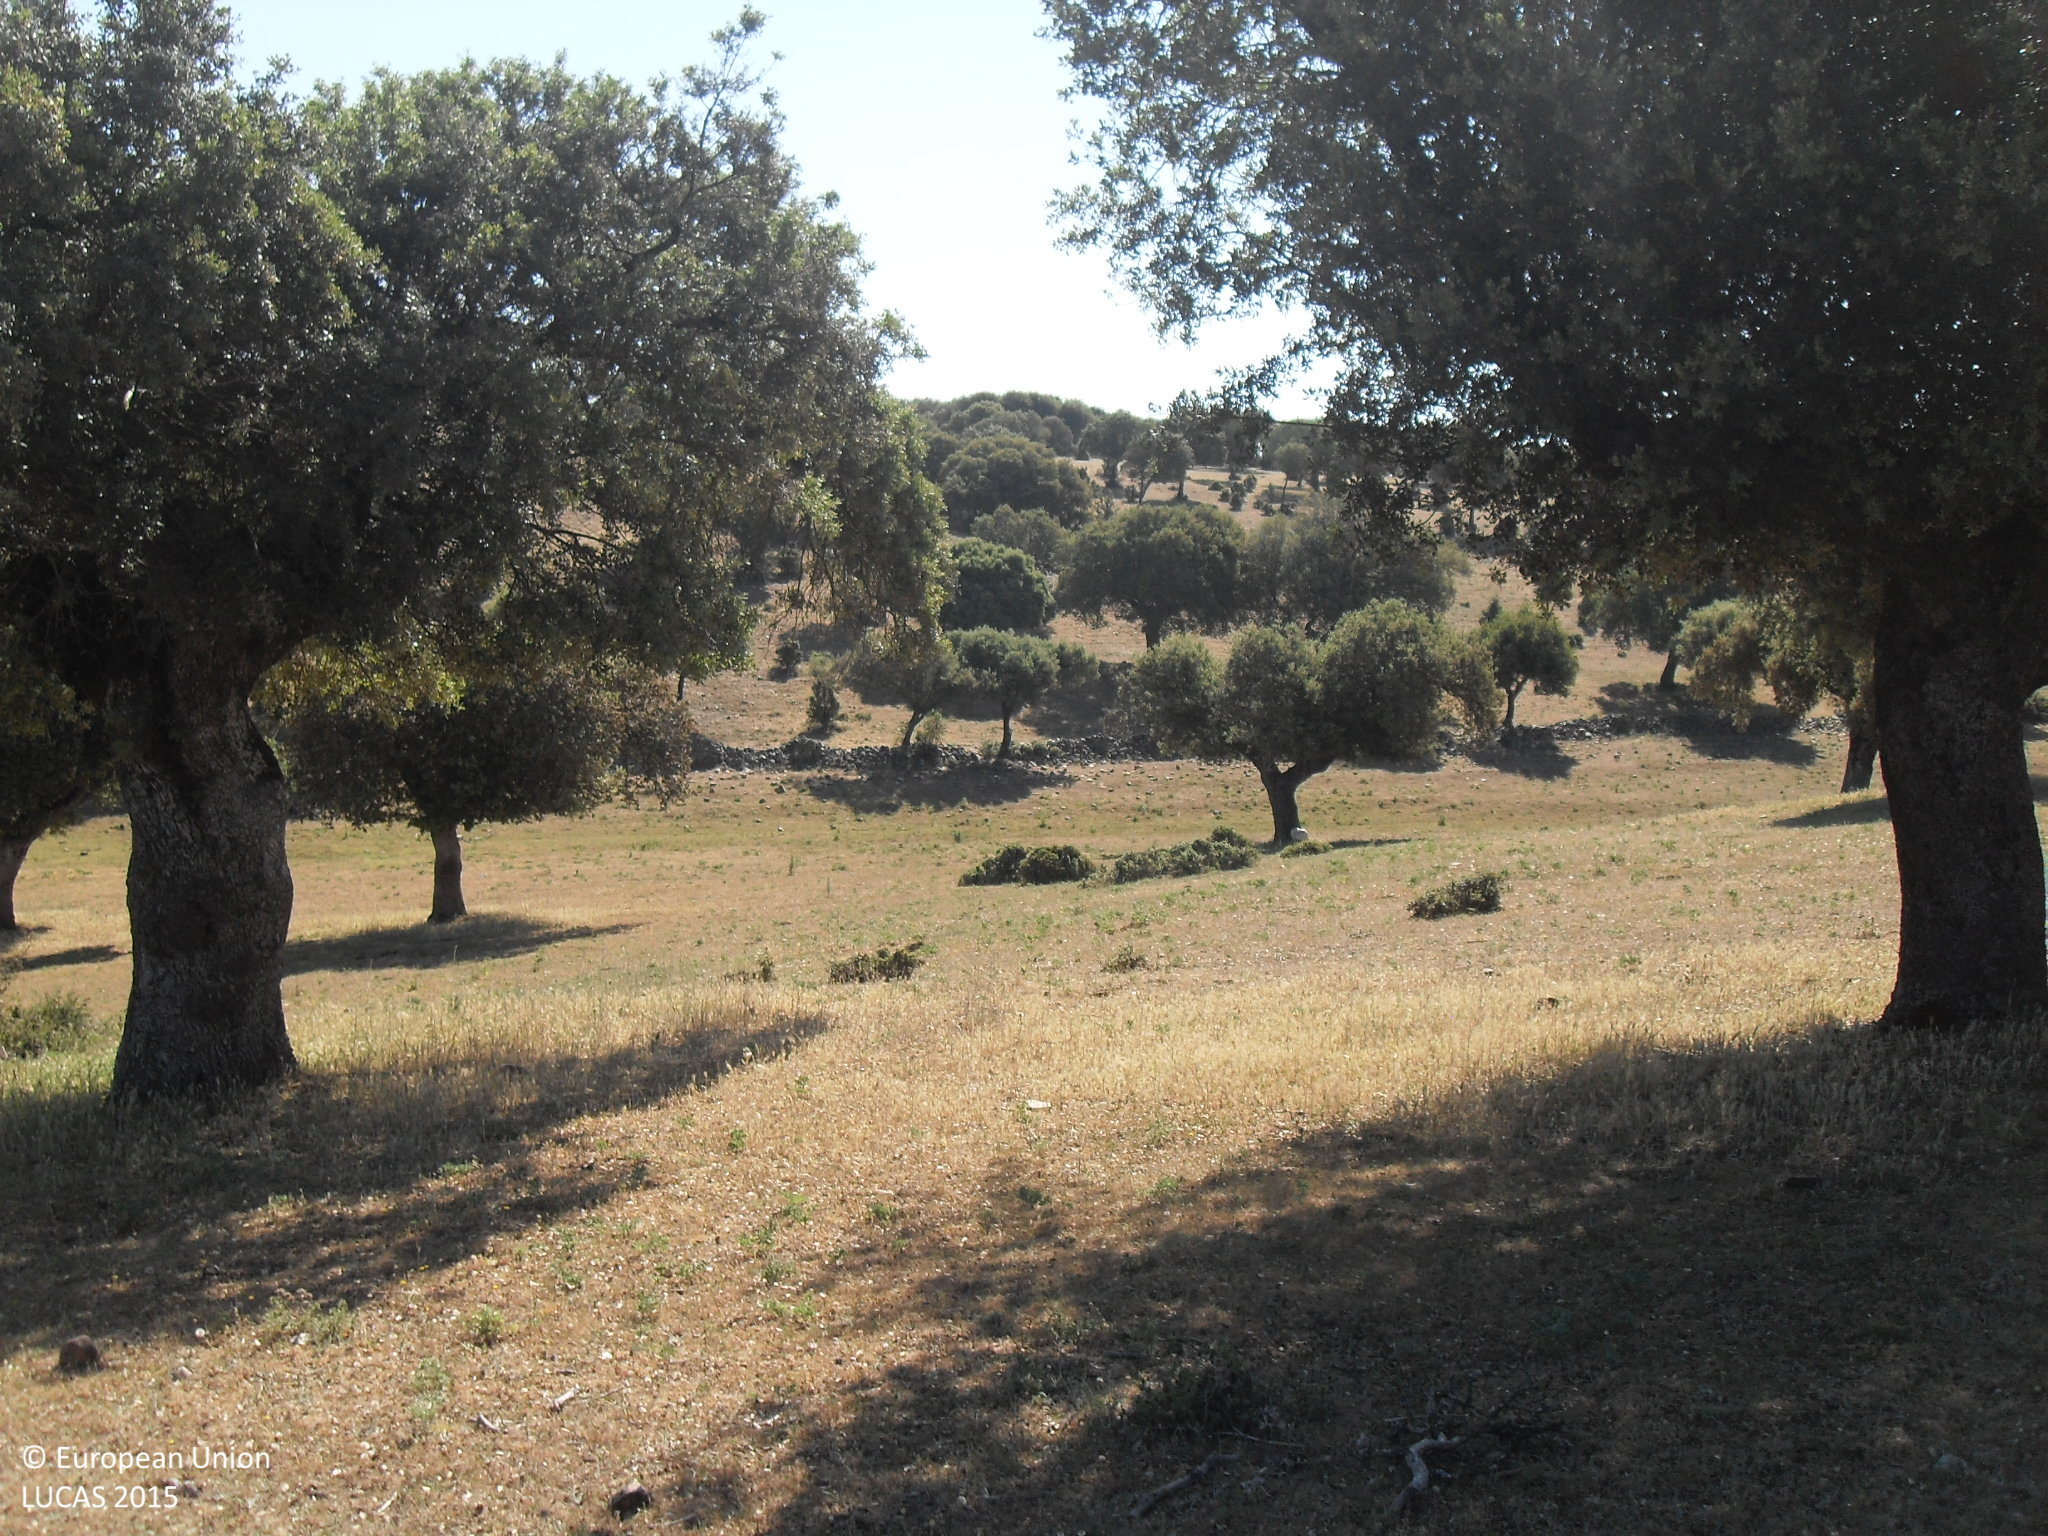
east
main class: Woodland
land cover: Broadleaved woodland
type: broadleaved evergreen forest
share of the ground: 10 - 25 %
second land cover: Grassland without tree/shrub cover
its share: > 75 %
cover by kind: herbaceous plants 80 %, broadleaved forest trees 15 %, shrubs 5 %
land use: Forestry
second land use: Agriculture (excluding fallow land and kitchen gardens)
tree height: > 5 m
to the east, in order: Broadleaved woodland; Grassland without tree/shrub cover; Broadleaved woodland; Dry stone walls; Broadleaved woodland
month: June
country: ES
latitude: 40.6685
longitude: -5.5797
